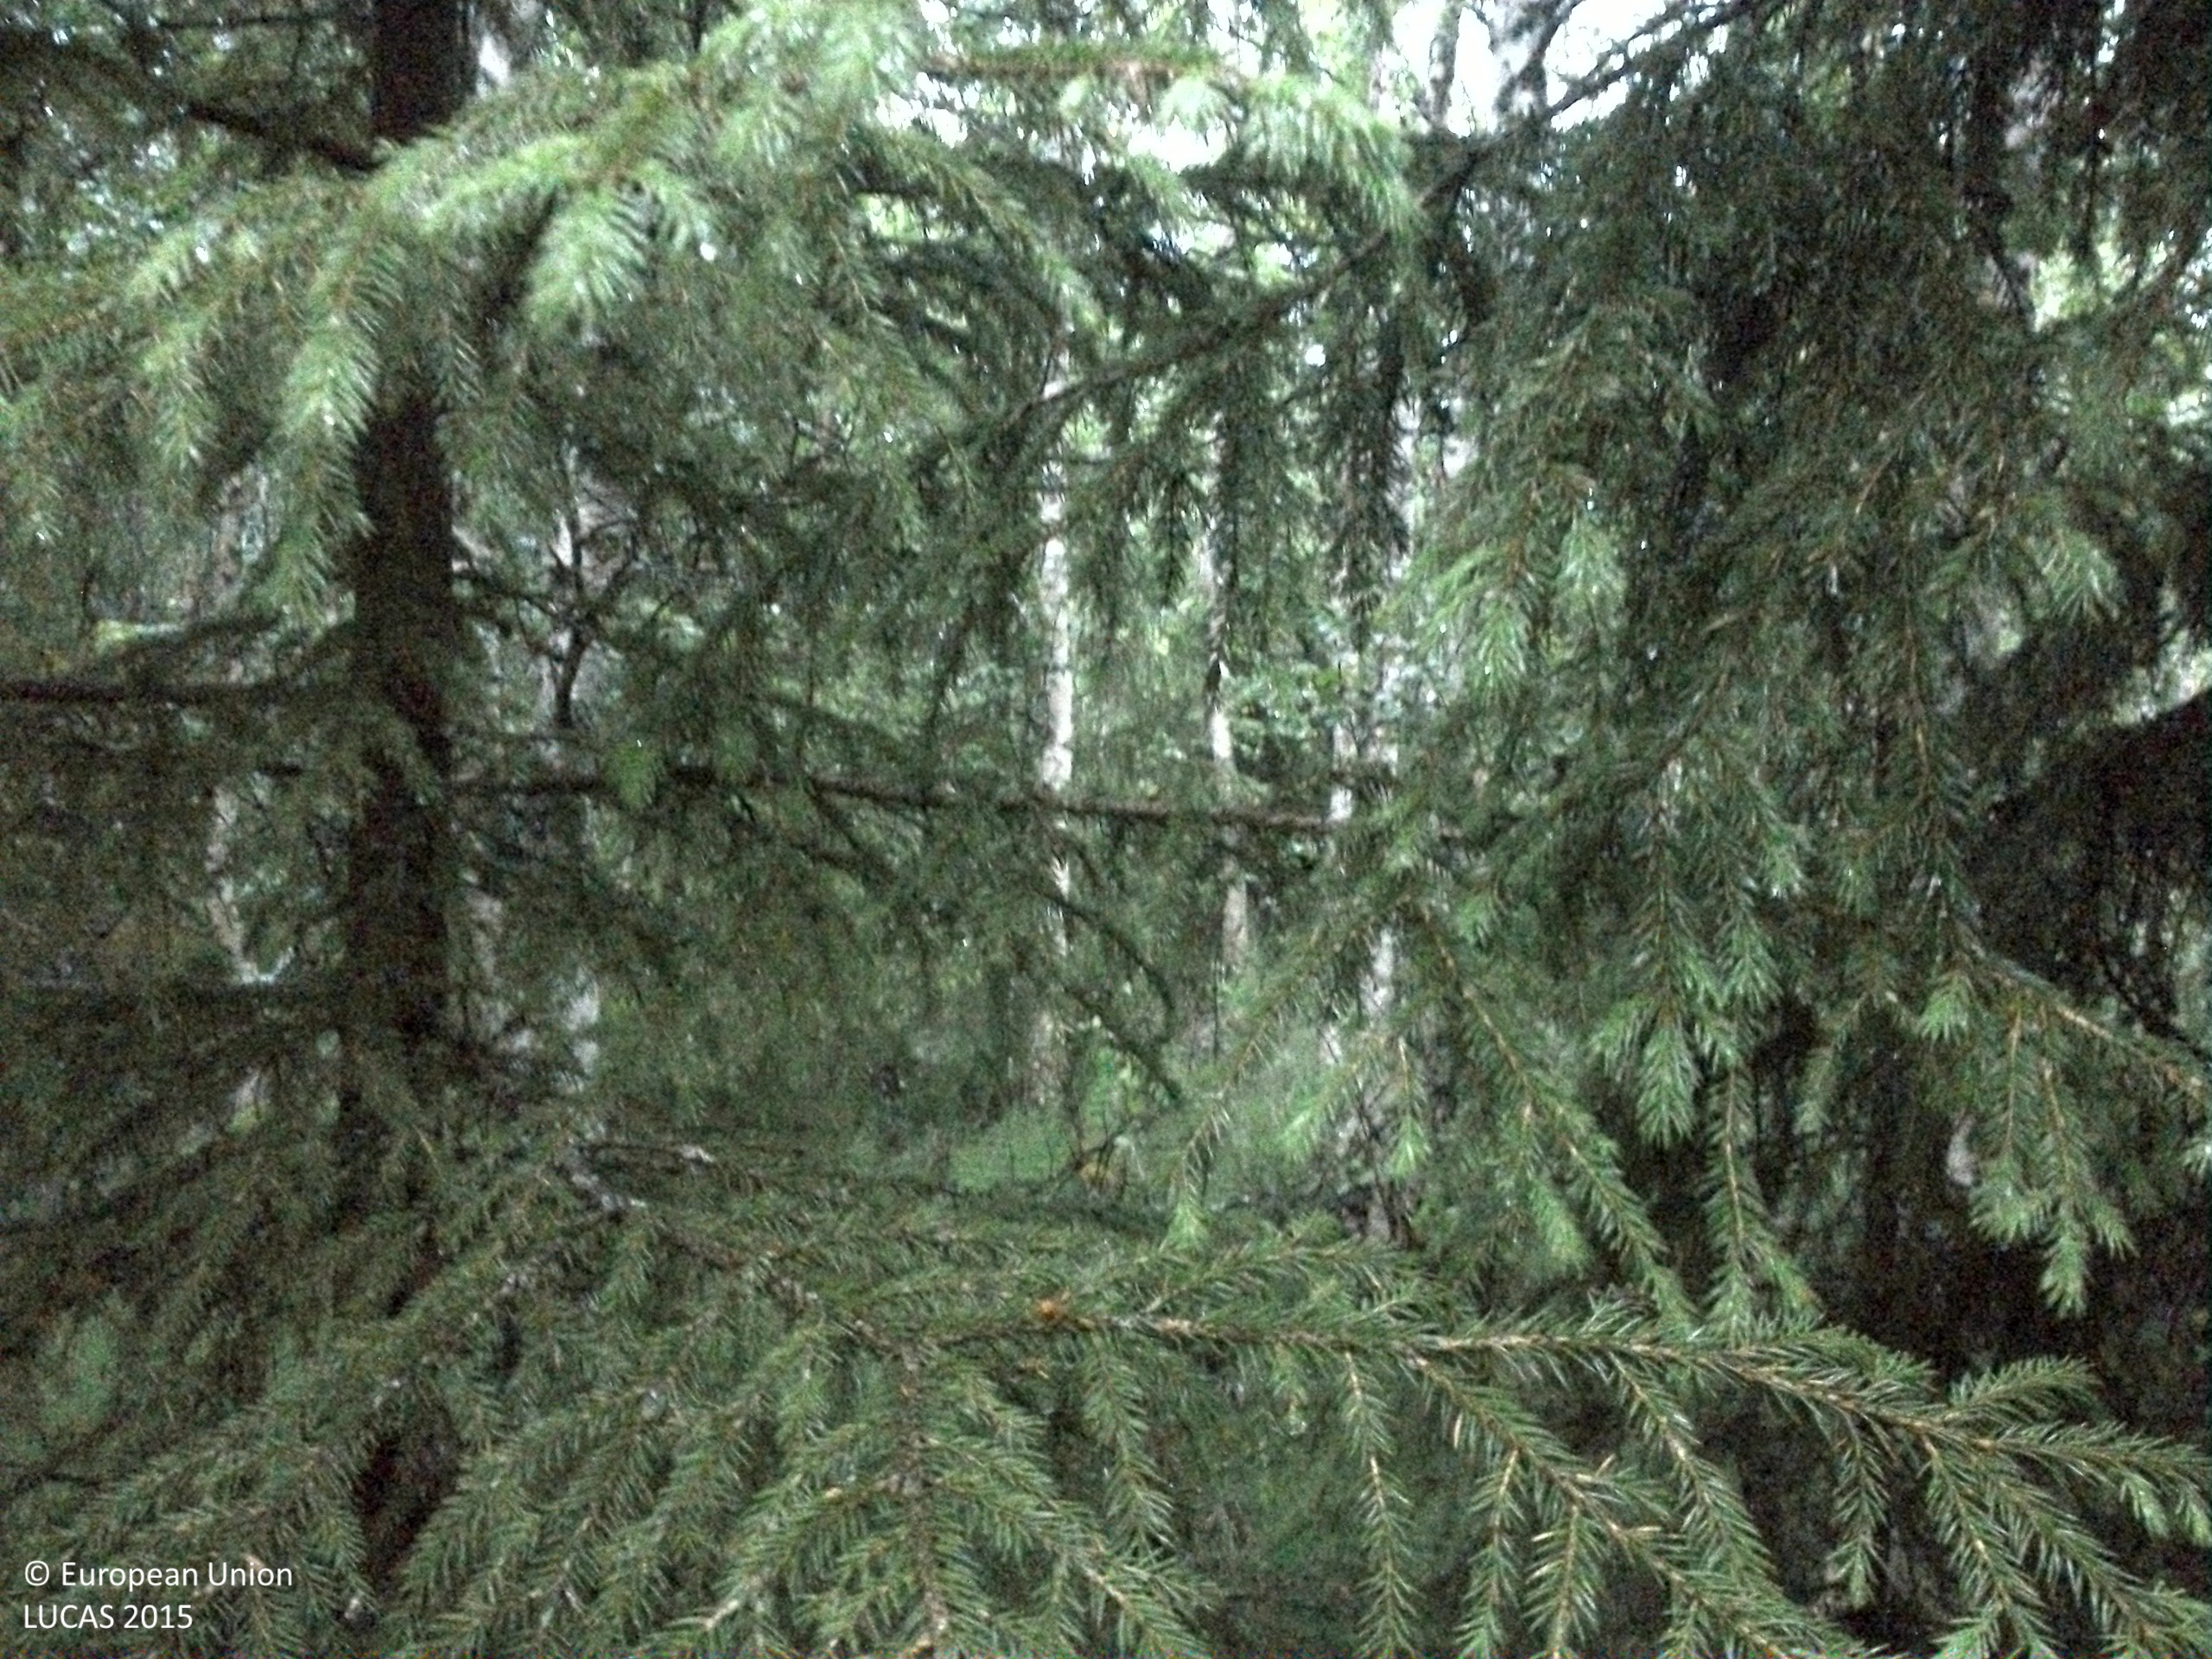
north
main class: Woodland
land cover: Other mixed woodland
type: boreal forest
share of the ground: > 75 %
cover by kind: broadleaved forest trees 45 %, coniferous forest trees 40 %, herbaceous plants 10 %, lichens and mosses 5 %
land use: Forestry
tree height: > 5 m
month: July
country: SE
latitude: 64.4784
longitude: 16.1468
